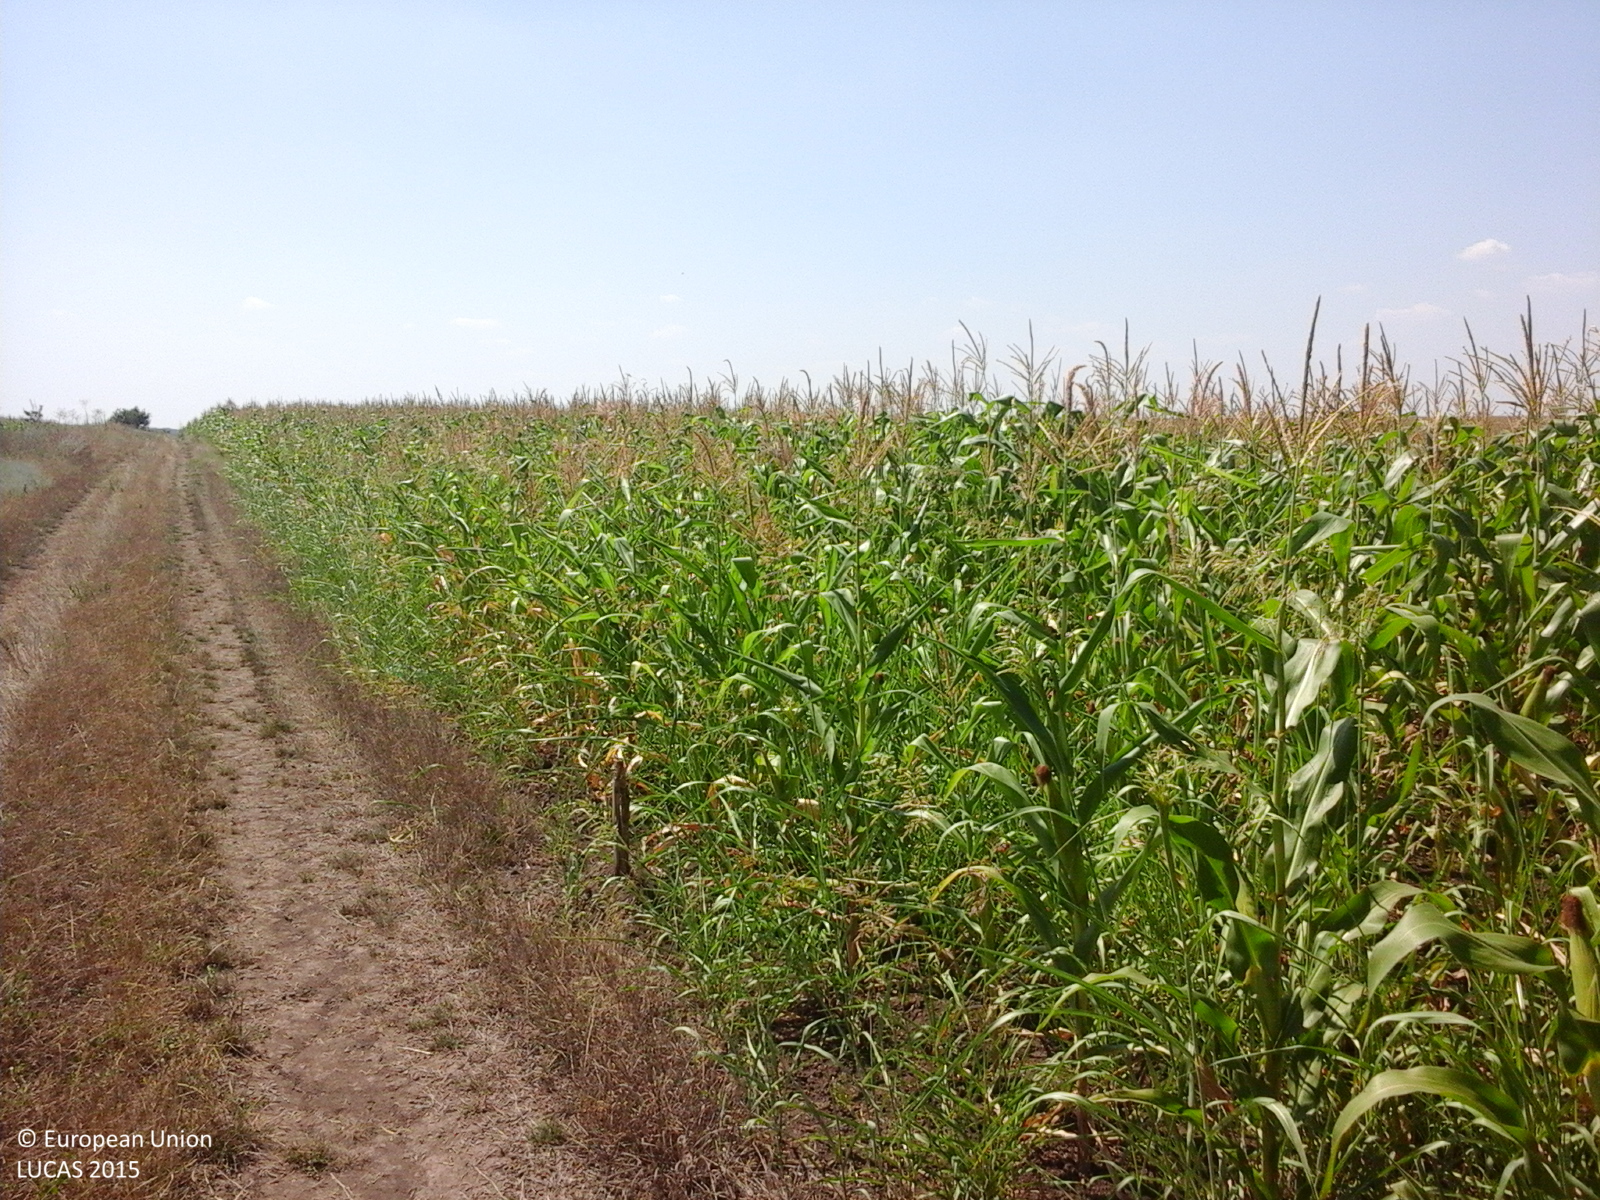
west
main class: Cropland
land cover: Maize
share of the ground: > 75 %
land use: Agriculture (excluding fallow land and kitchen gardens)
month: July
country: RO
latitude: 44.2738
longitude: 27.0283
